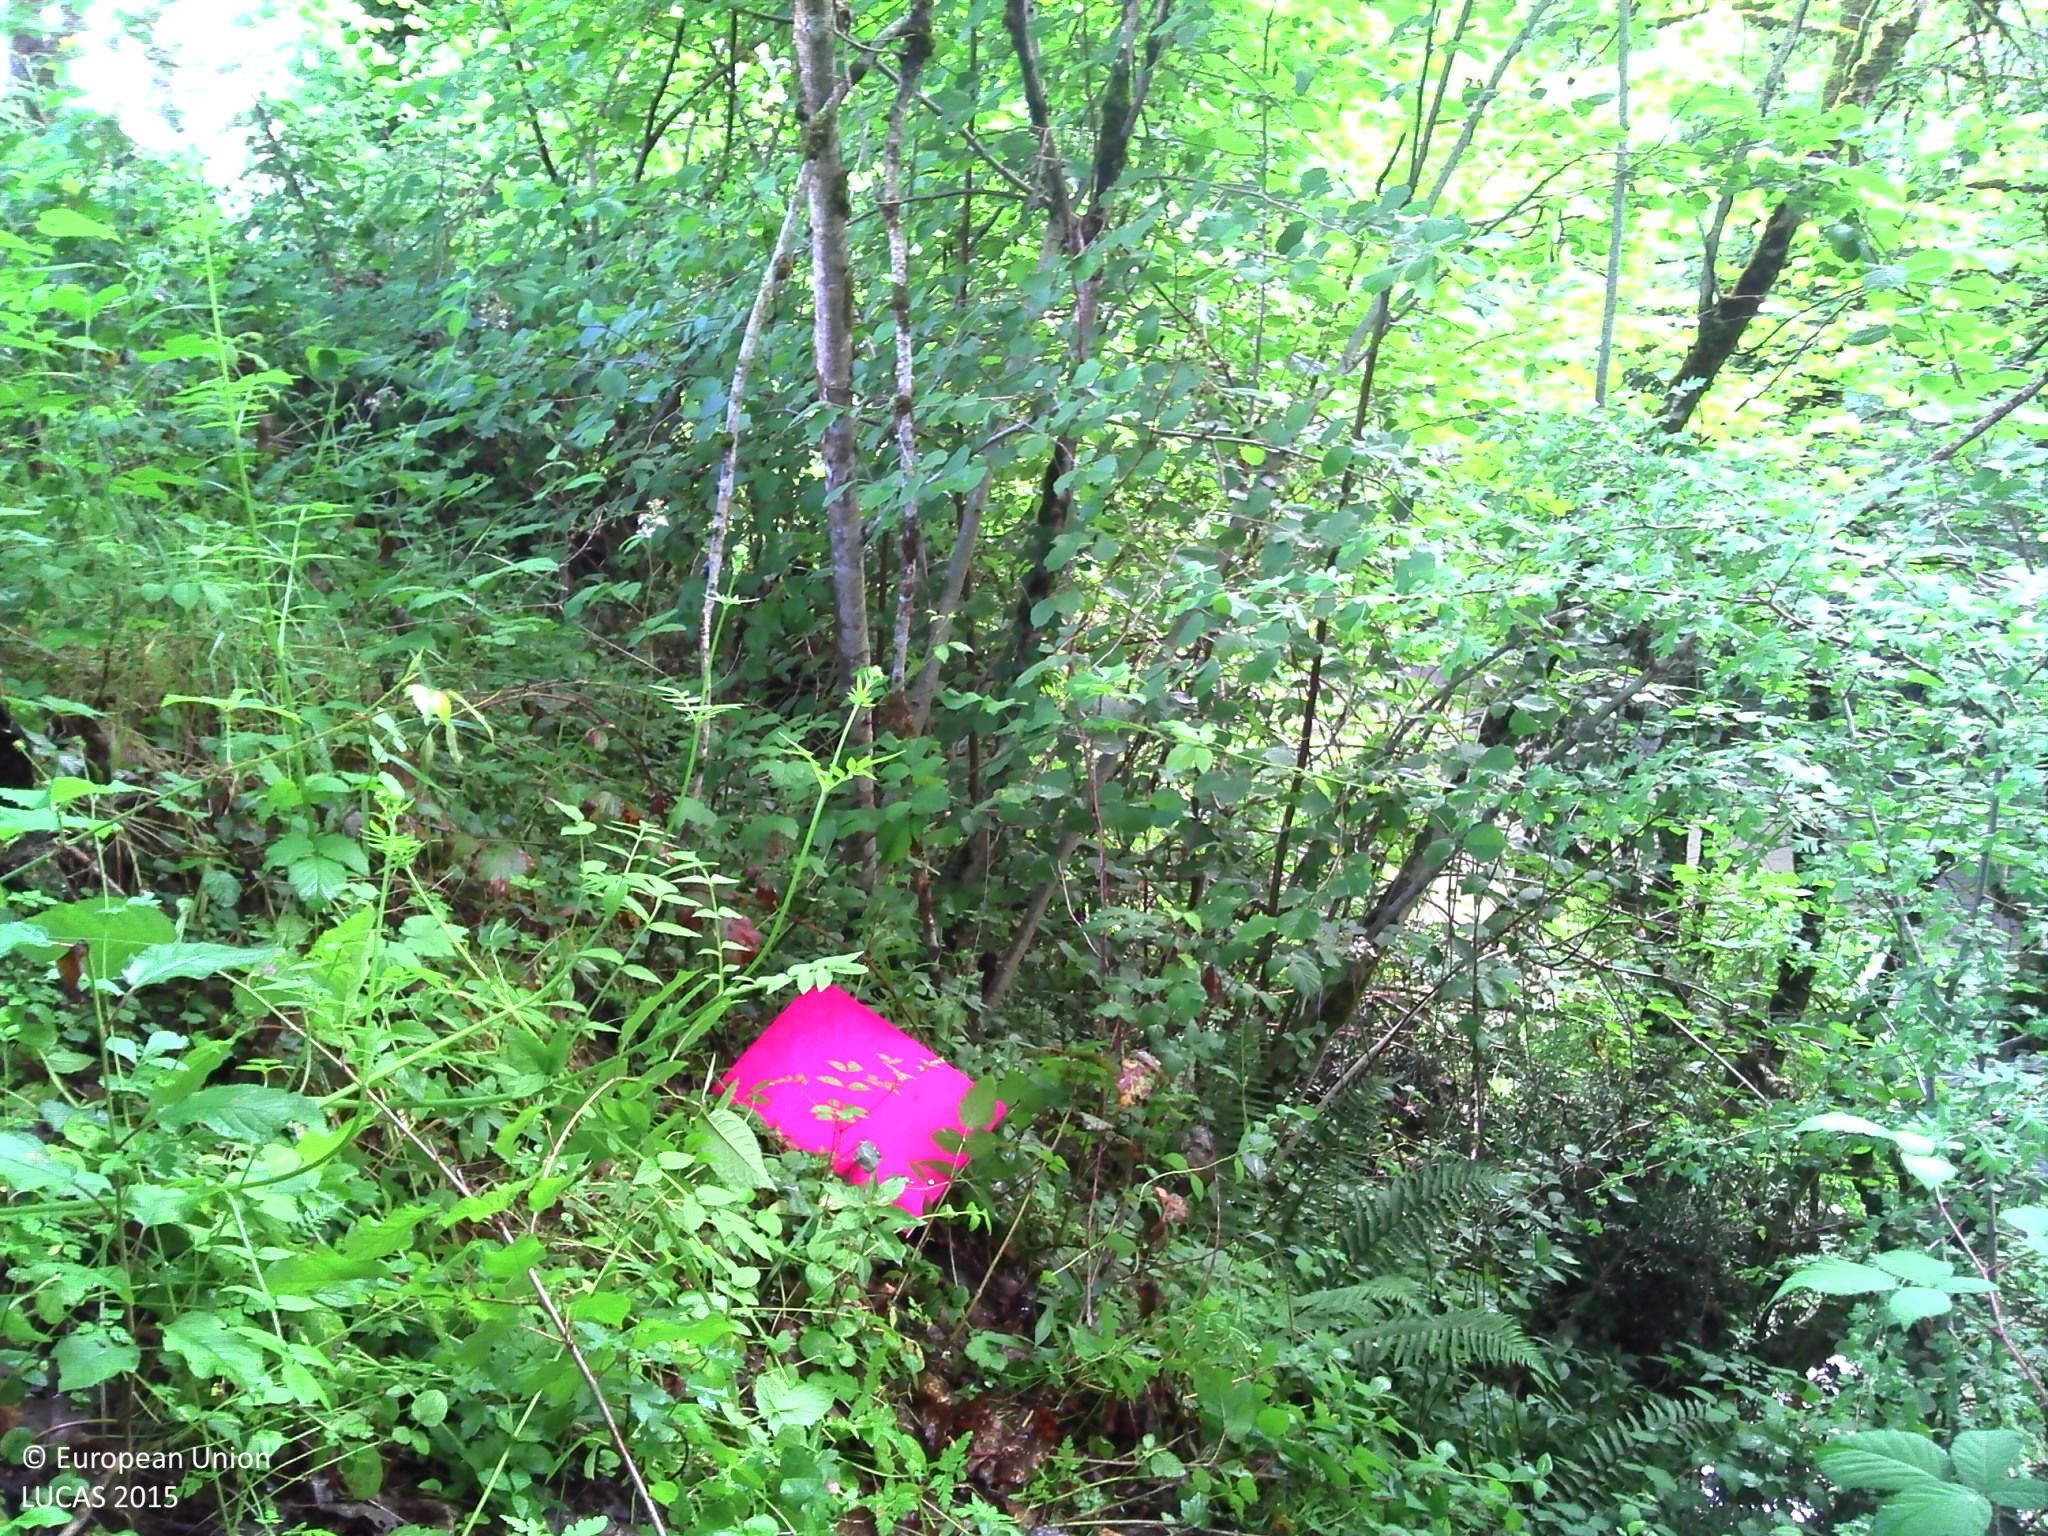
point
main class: Woodland
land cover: Broadleaved woodland
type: acidophilous oak and oak-birch forest
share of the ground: > 75 %
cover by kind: broadleaved forest trees 70 %, shrubs 10 %, herbaceous plants 10 %, lichens and mosses 10 %
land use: Forestry
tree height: > 5 m
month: June
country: FR
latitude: 43.2183
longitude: -0.6570
